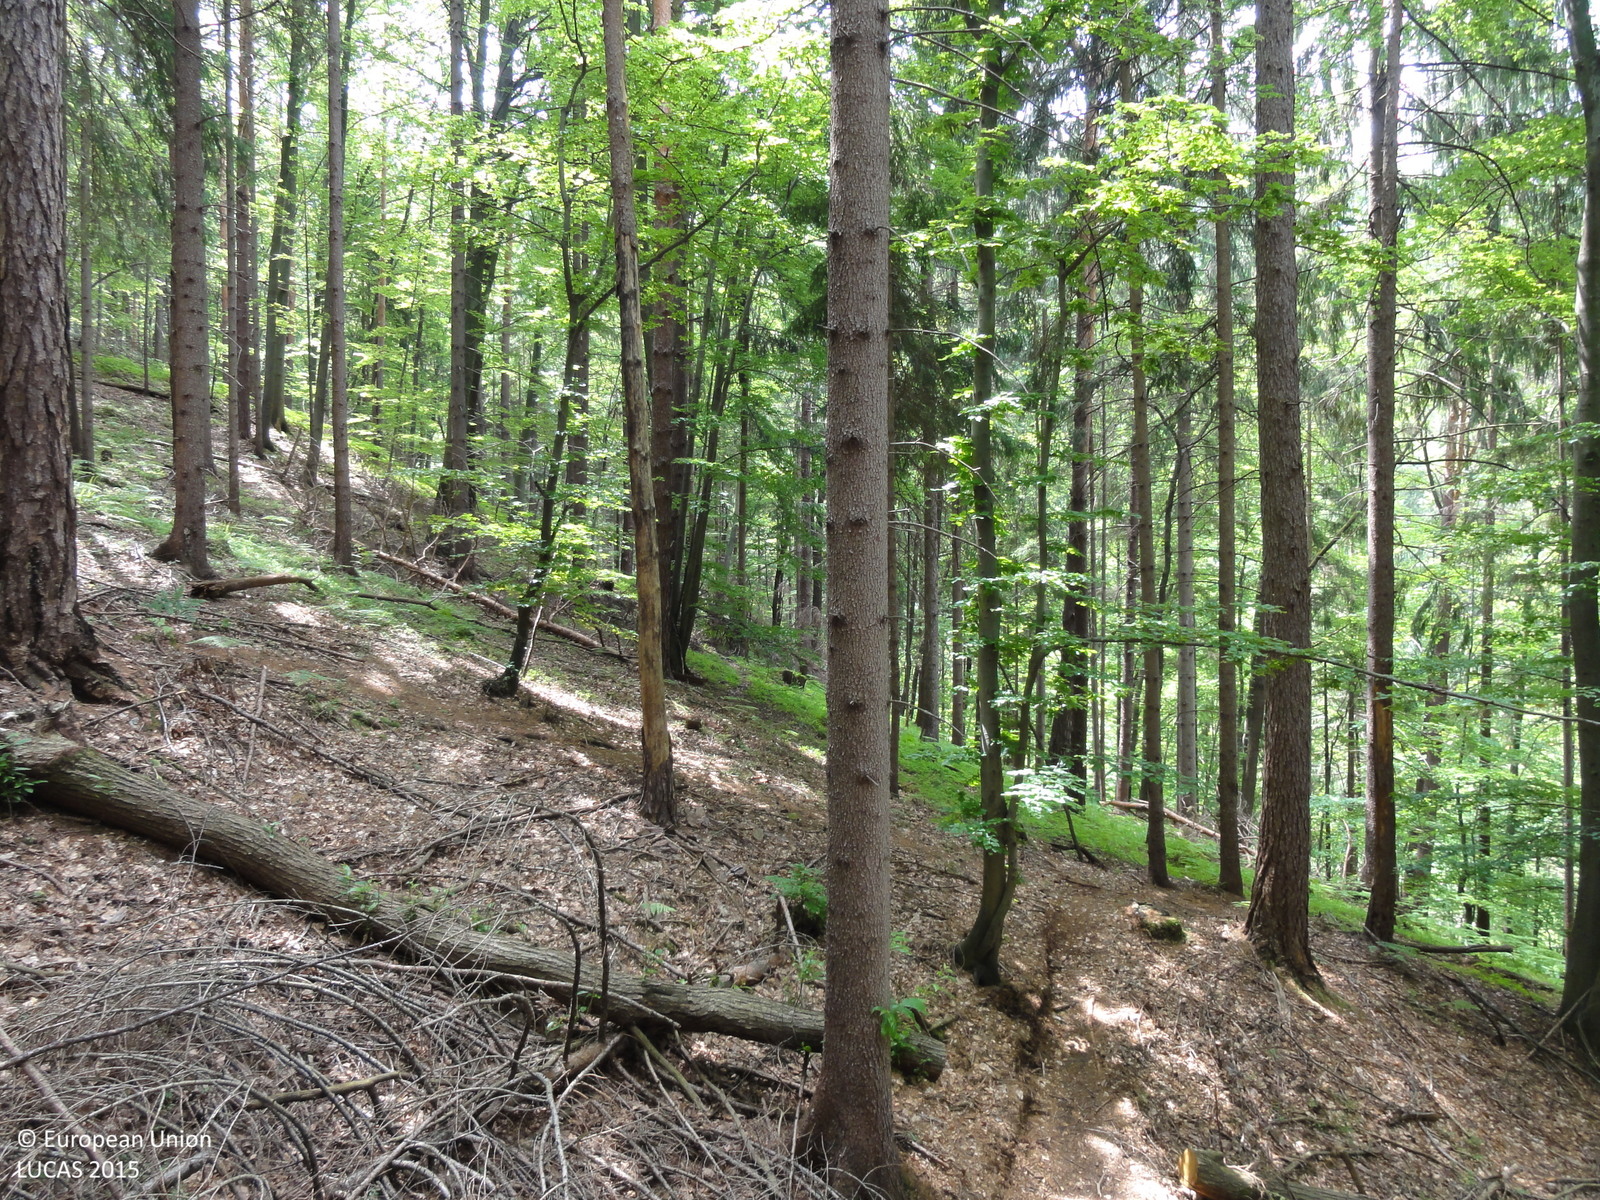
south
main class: Woodland
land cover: Other mixed woodland
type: mountainous beech forest
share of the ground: > 75 %
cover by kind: coniferous forest trees 50 %, broadleaved forest trees 50 %
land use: Forestry
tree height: > 5 m
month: May
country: SI
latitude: 46.2299
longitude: 15.0932
